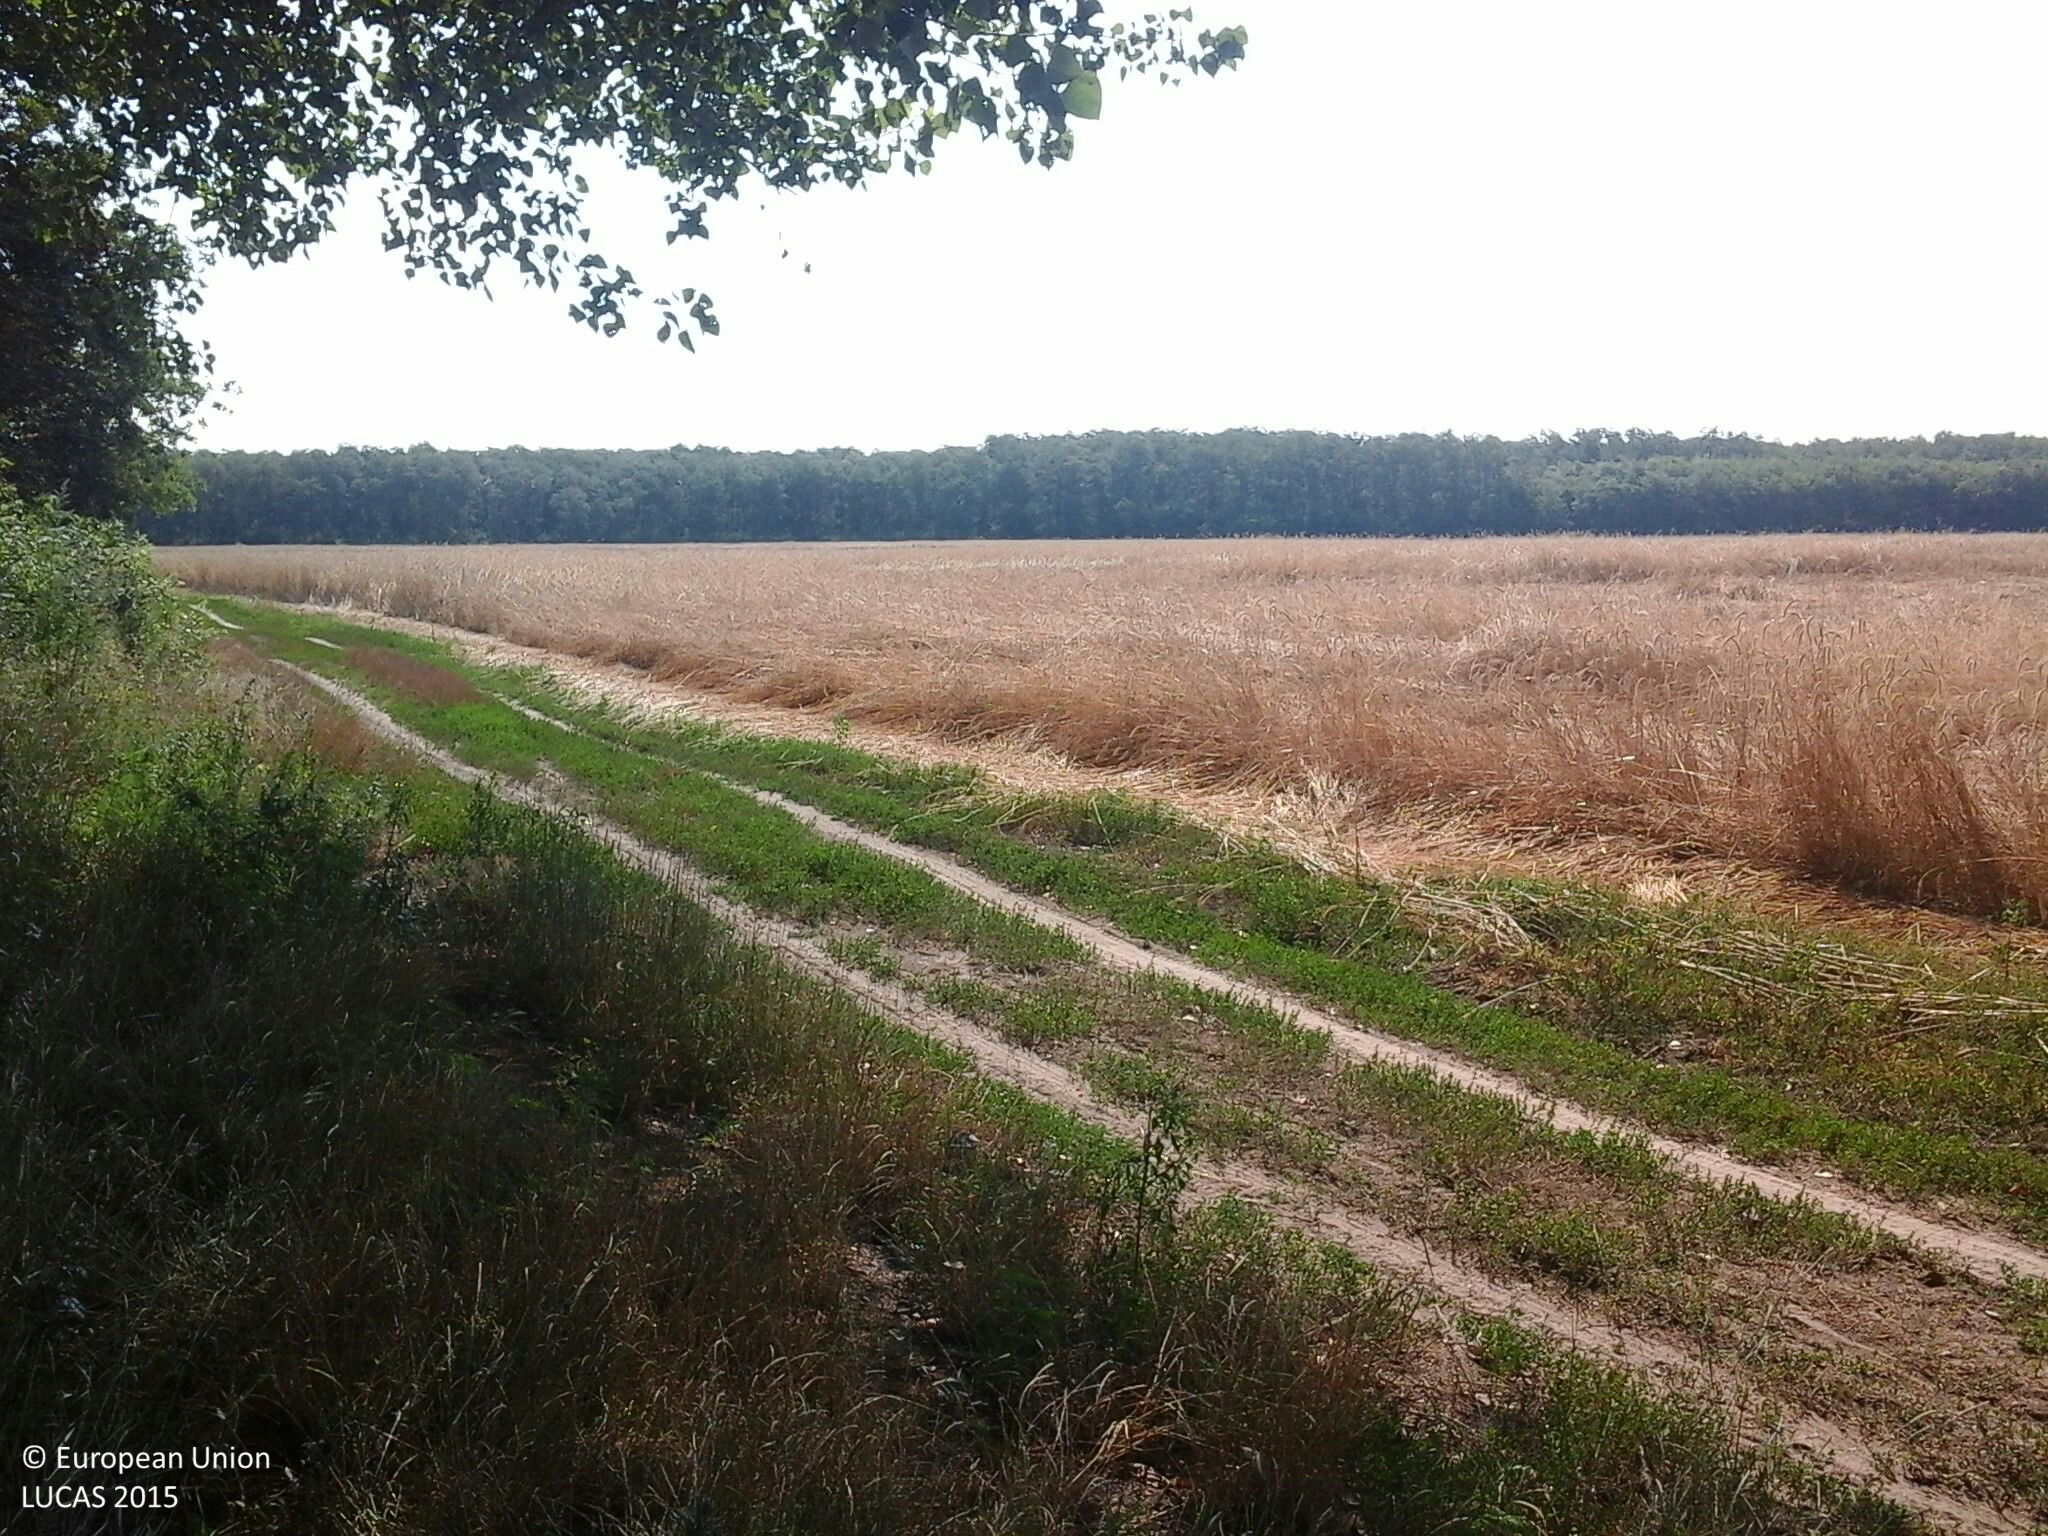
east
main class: Woodland
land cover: Broadleaved woodland
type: mesophytic deciduous forest
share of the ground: > 75 %
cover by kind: broadleaved forest trees 95 %, herbaceous plants 5 %
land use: Forestry
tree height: > 5 m
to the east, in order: Broadleaved woodland; Tracks; Common wheat
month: July
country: HU
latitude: 47.7959
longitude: 22.2162
